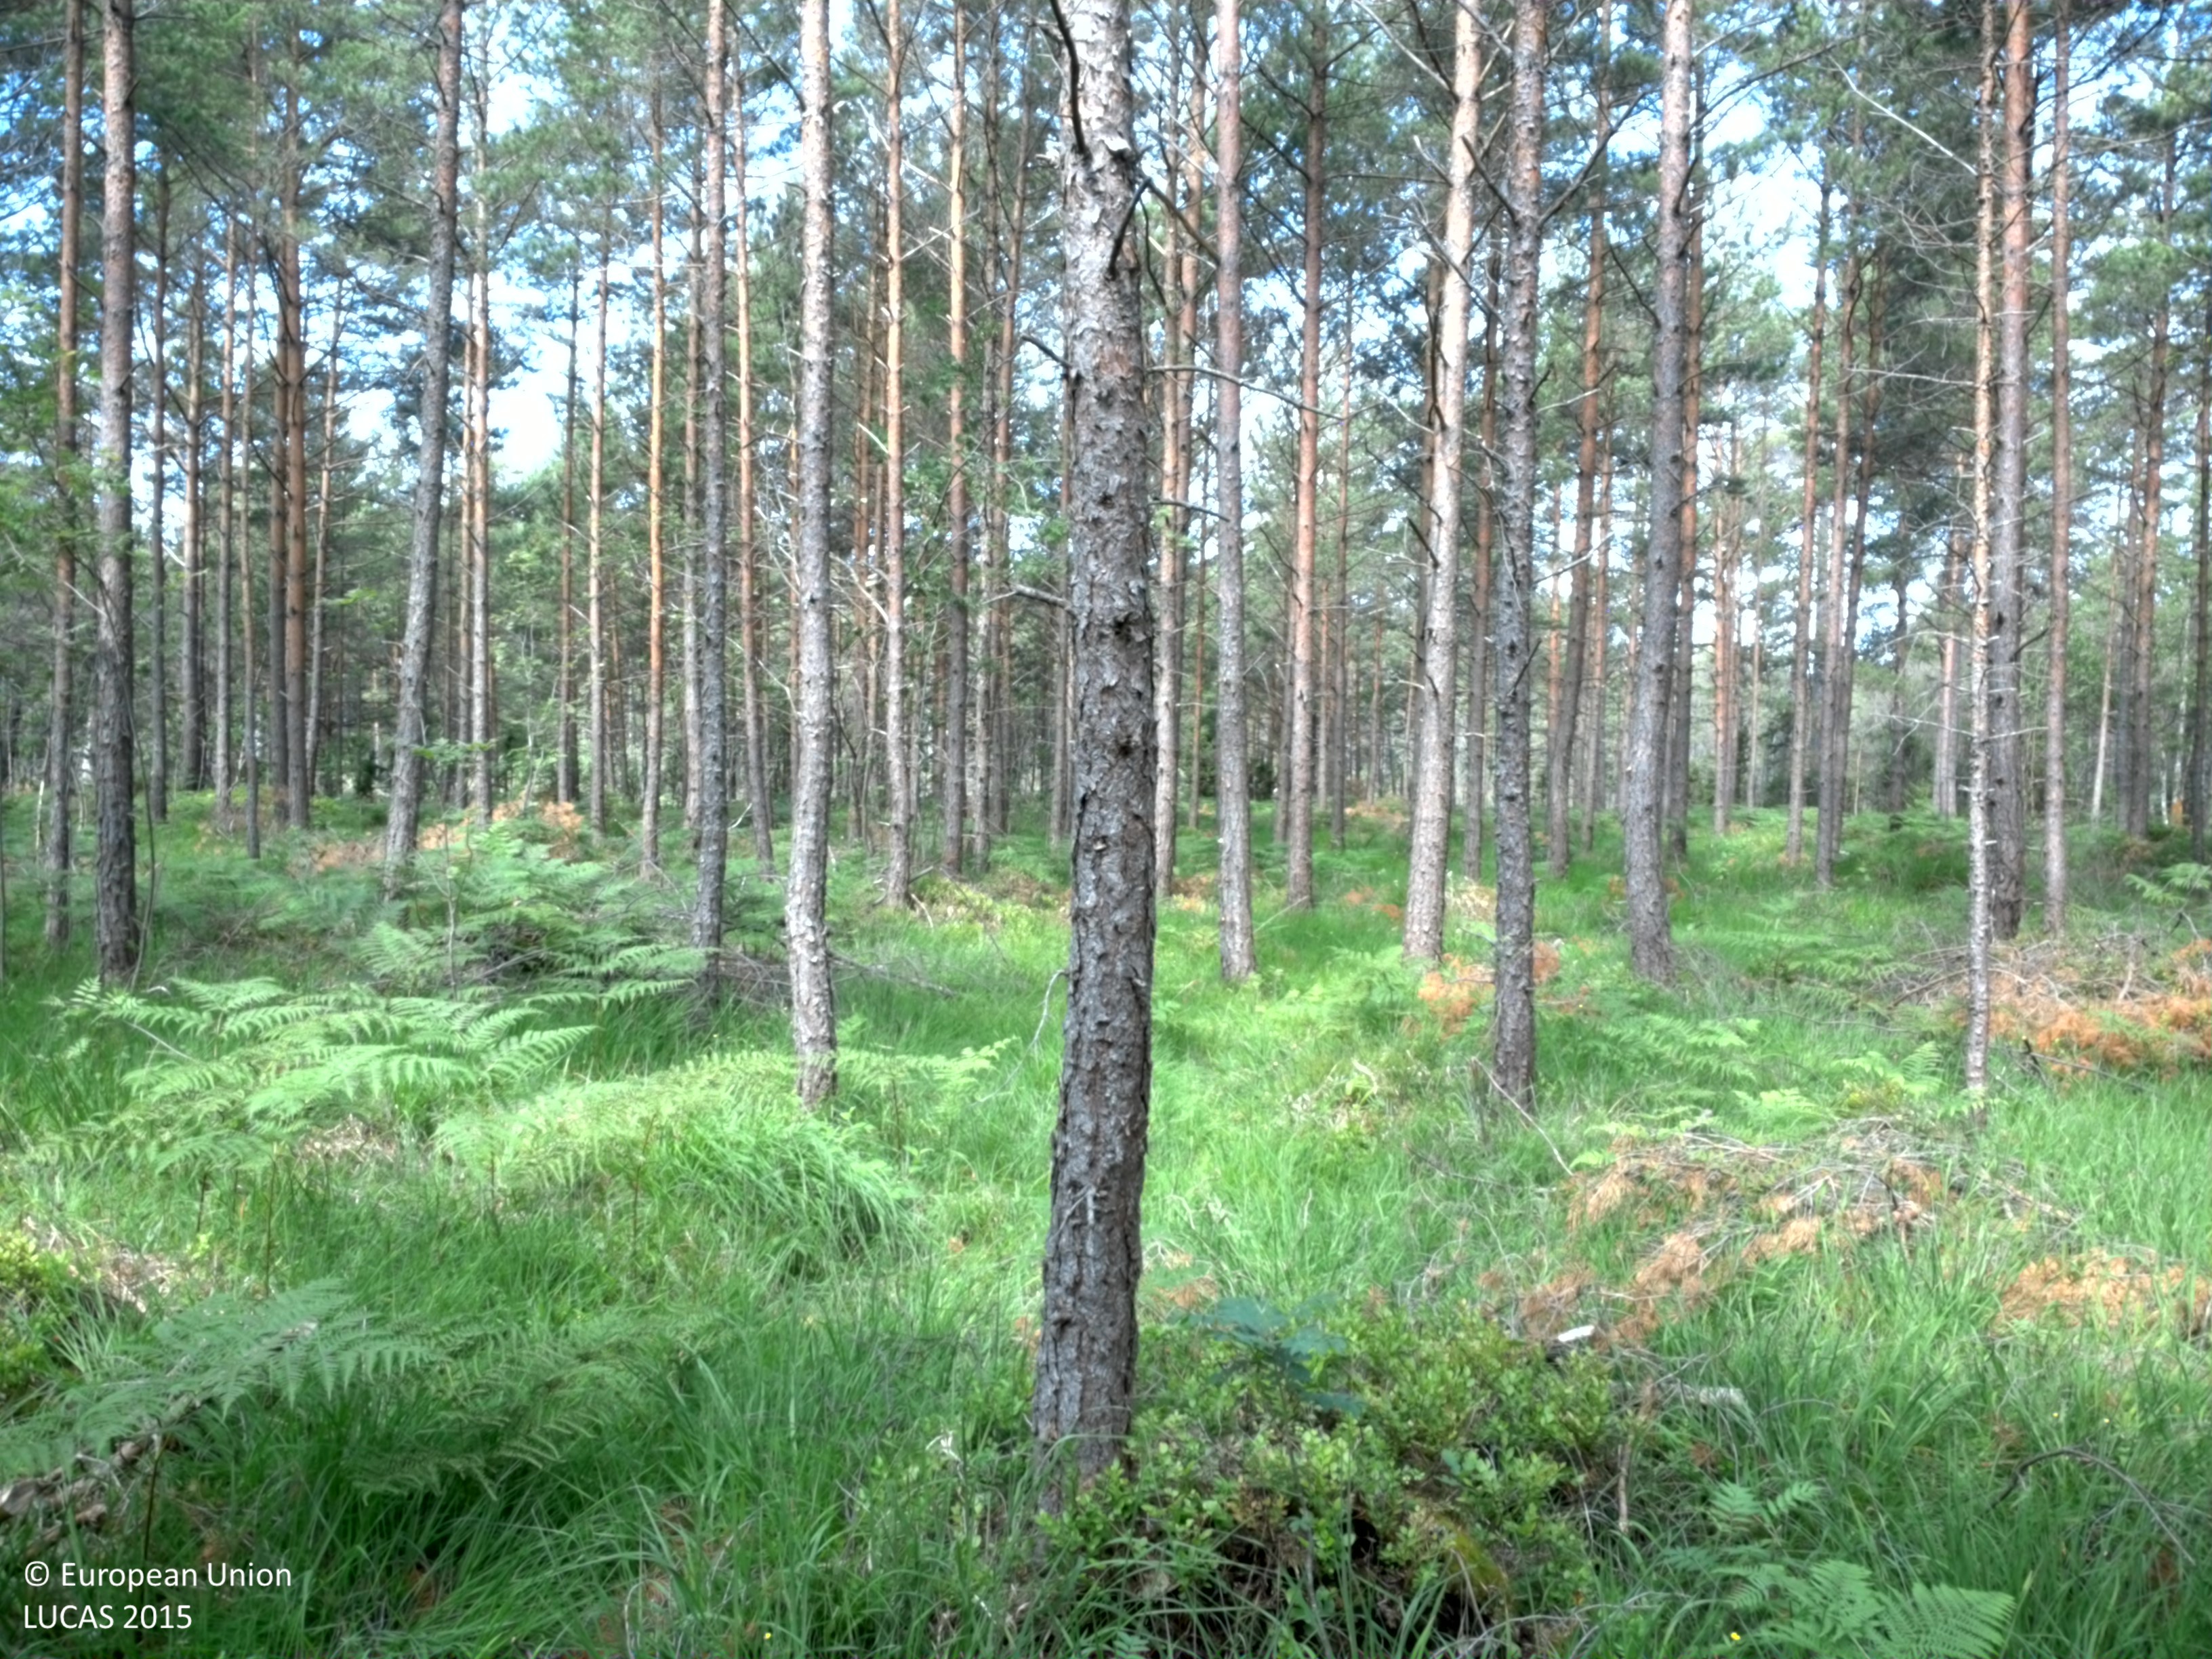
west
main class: Woodland
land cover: Pine dominated mixed woodland
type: hemiboreal forest and nemoral coniferous forest and mixed broadleaved-coniferous forest
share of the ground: 50 - 75 %
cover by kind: herbaceous plants 40 %, coniferous forest trees 35 %, broadleaved forest trees 20 %, shrubs 5 %
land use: Forestry
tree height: > 5 m
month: July
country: SE
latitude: 57.3932
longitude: 18.7125
